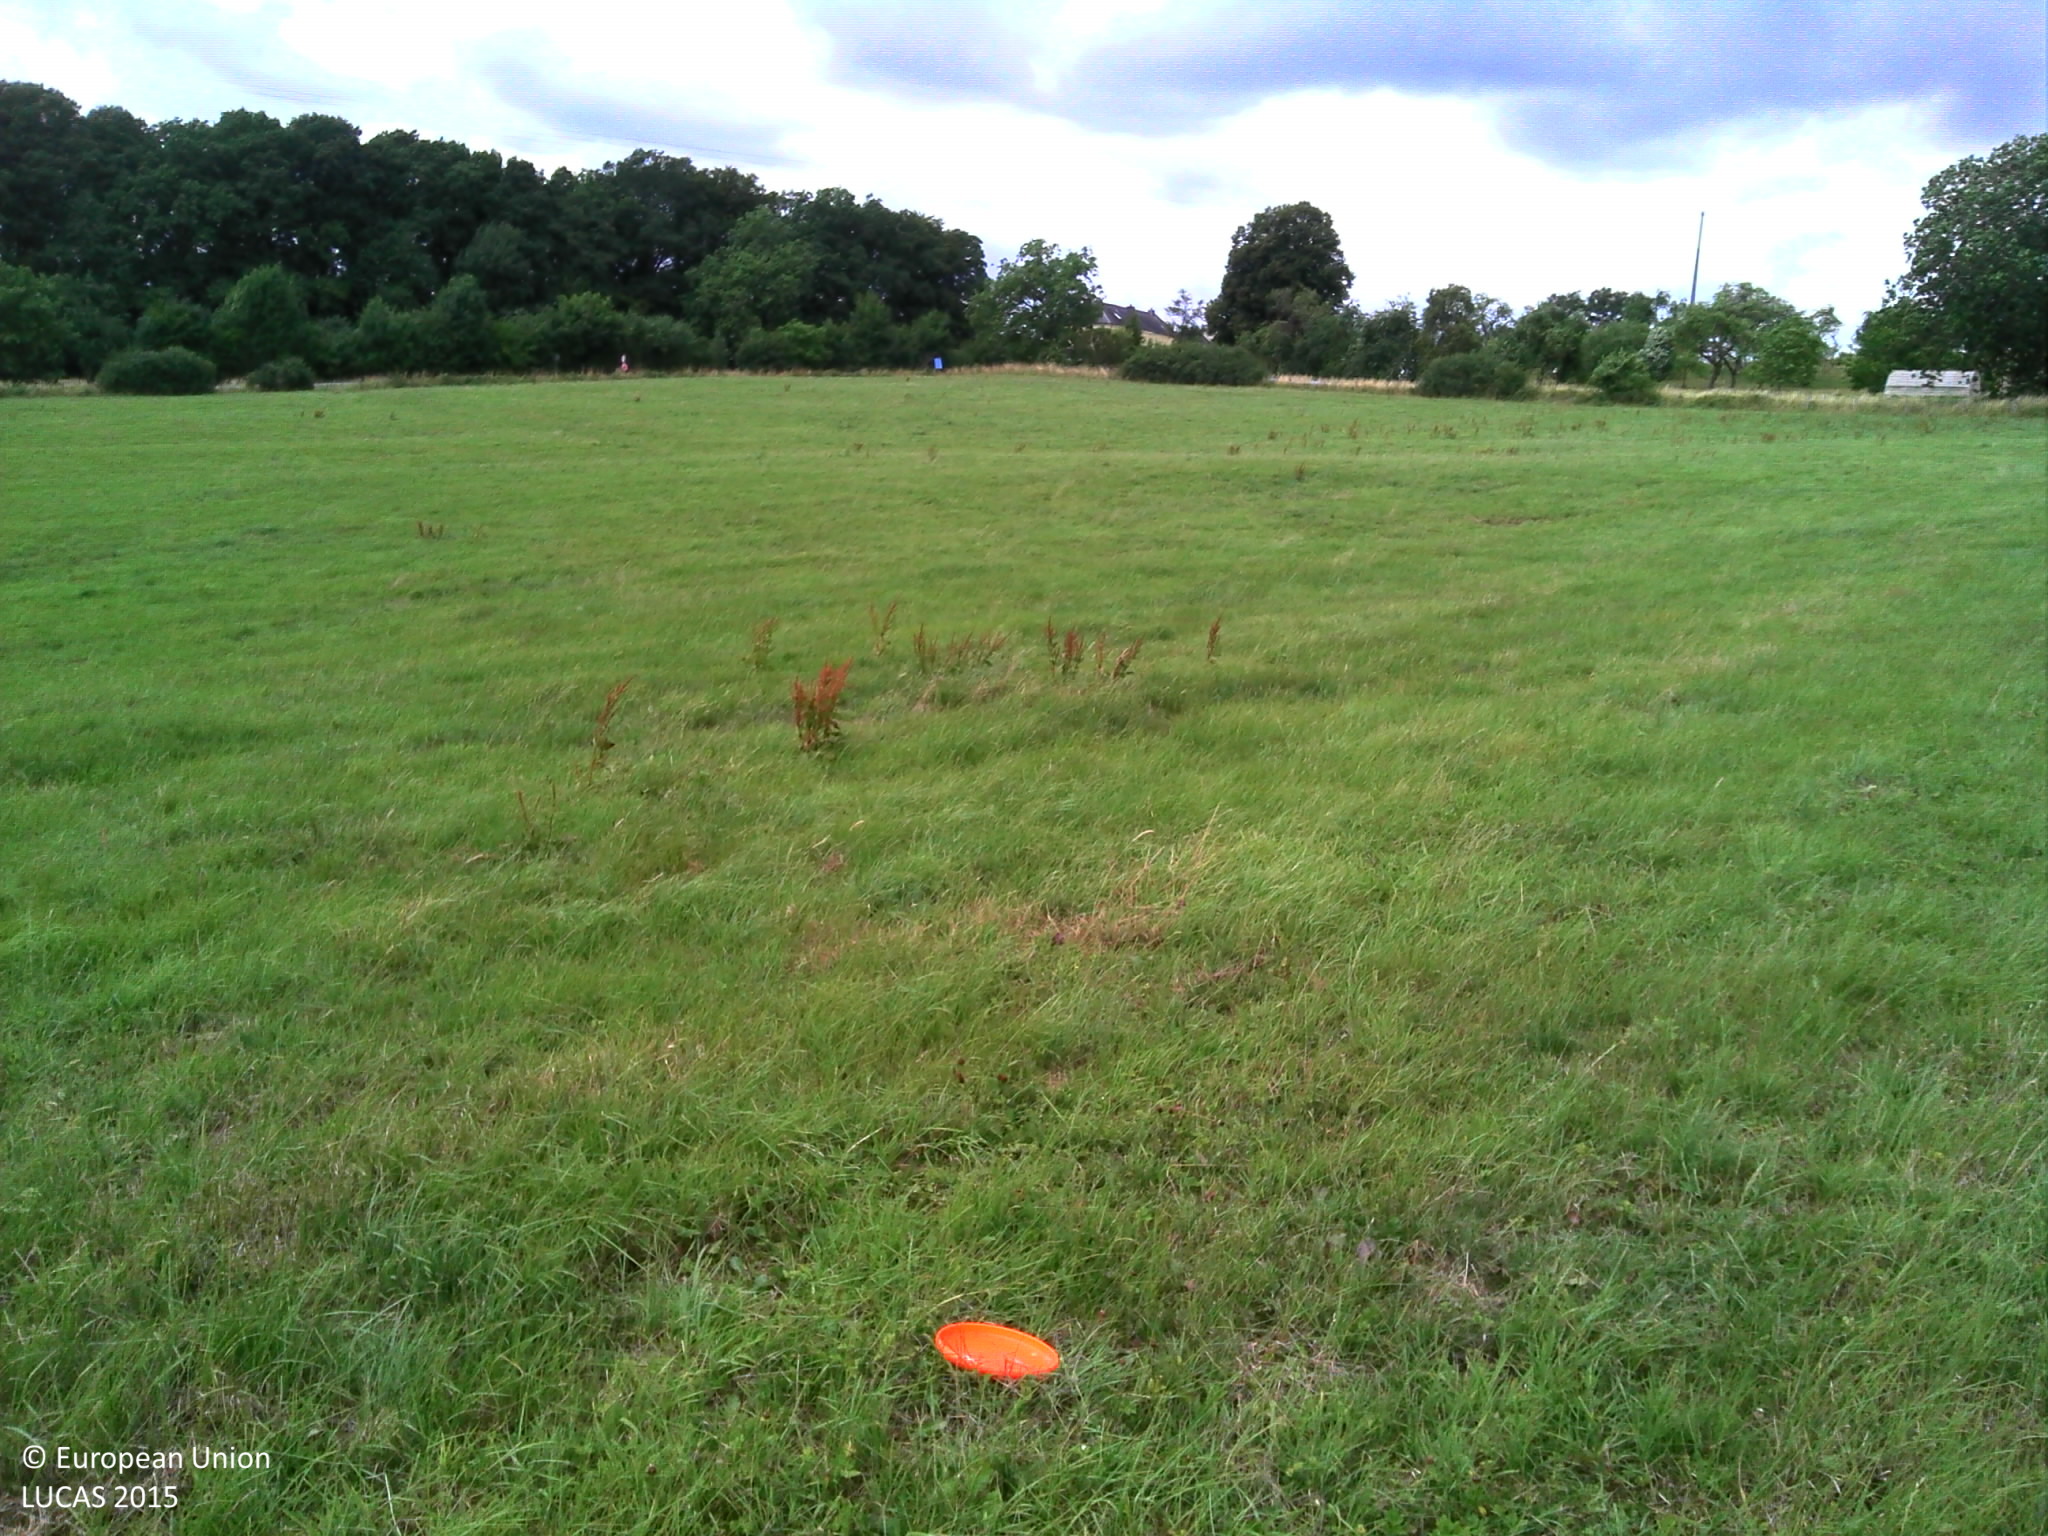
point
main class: Grassland
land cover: Grassland without tree/shrub cover
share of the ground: > 75 %
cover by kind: herbaceous plants 100 %
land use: Agriculture (excluding fallow land and kitchen gardens)
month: July
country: BE
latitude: 49.5977
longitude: 5.6682
